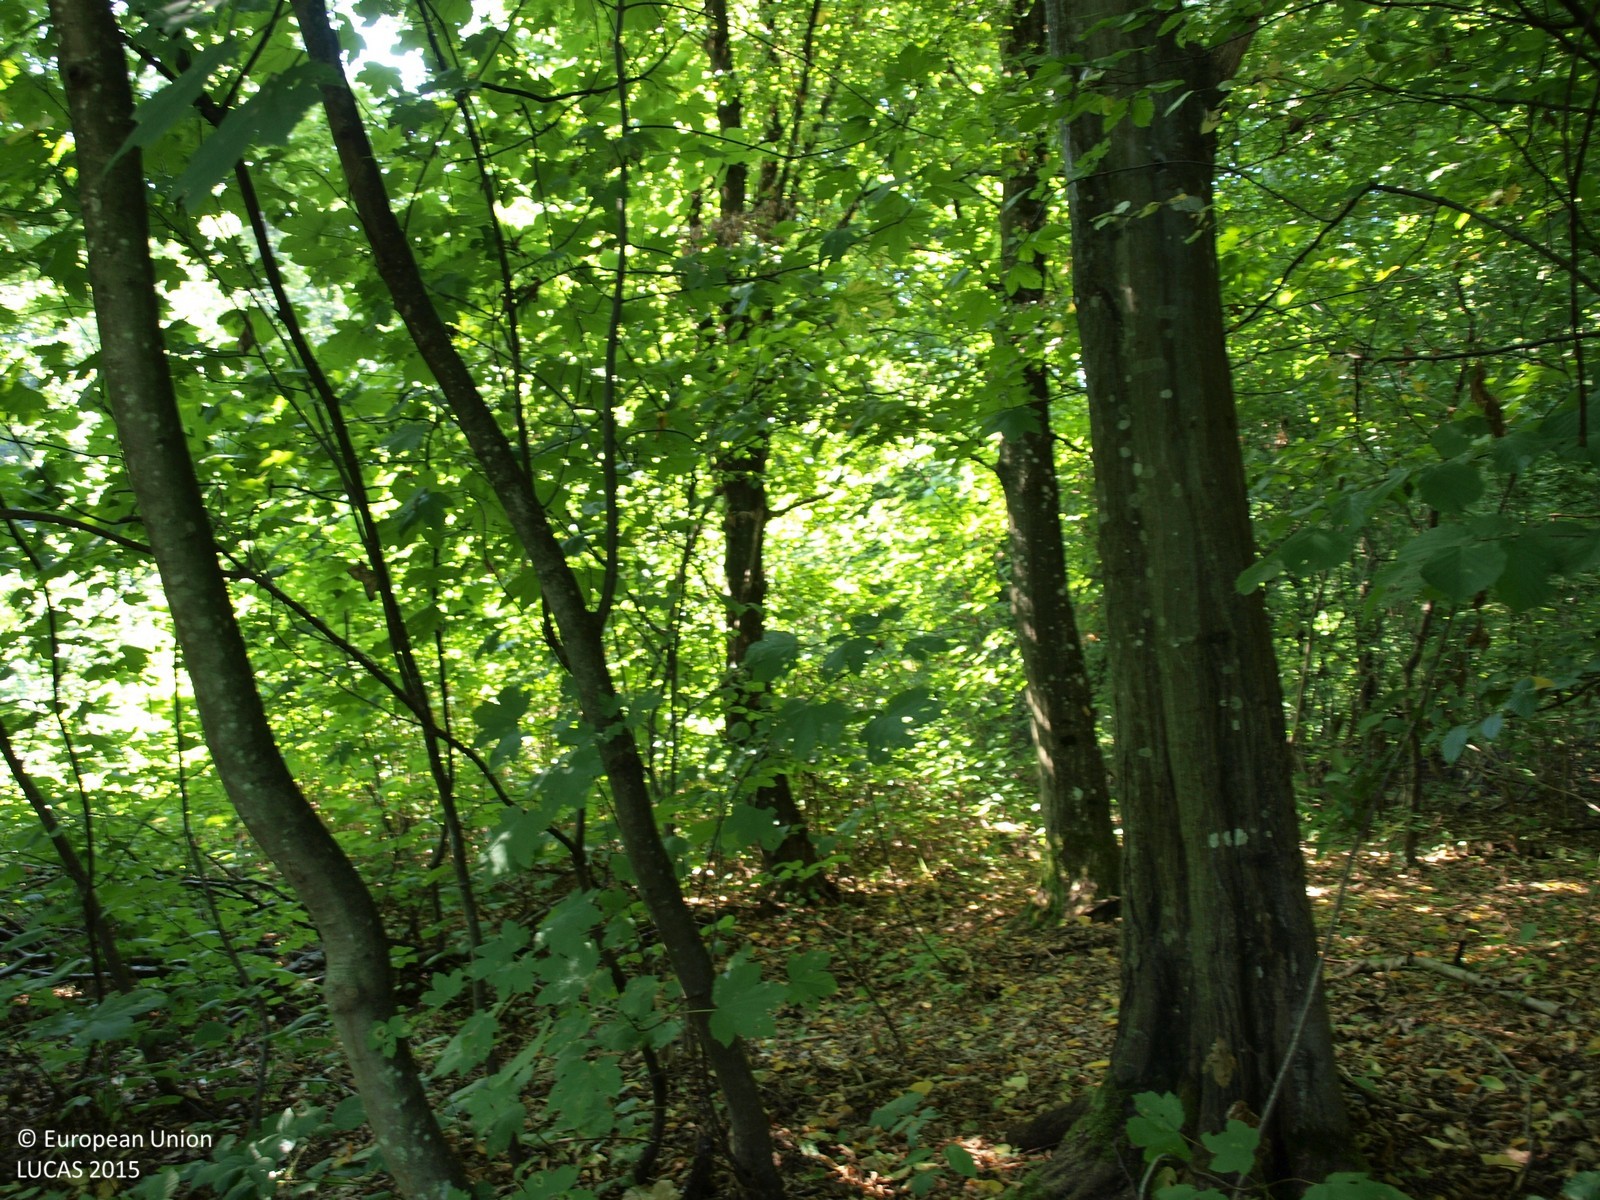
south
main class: Woodland
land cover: Broadleaved woodland
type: mesophytic deciduous forest
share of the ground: > 75 %
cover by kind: broadleaved forest trees 100 %
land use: Forestry
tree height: > 5 m
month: August
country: HR
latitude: 45.8780
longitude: 16.2733
